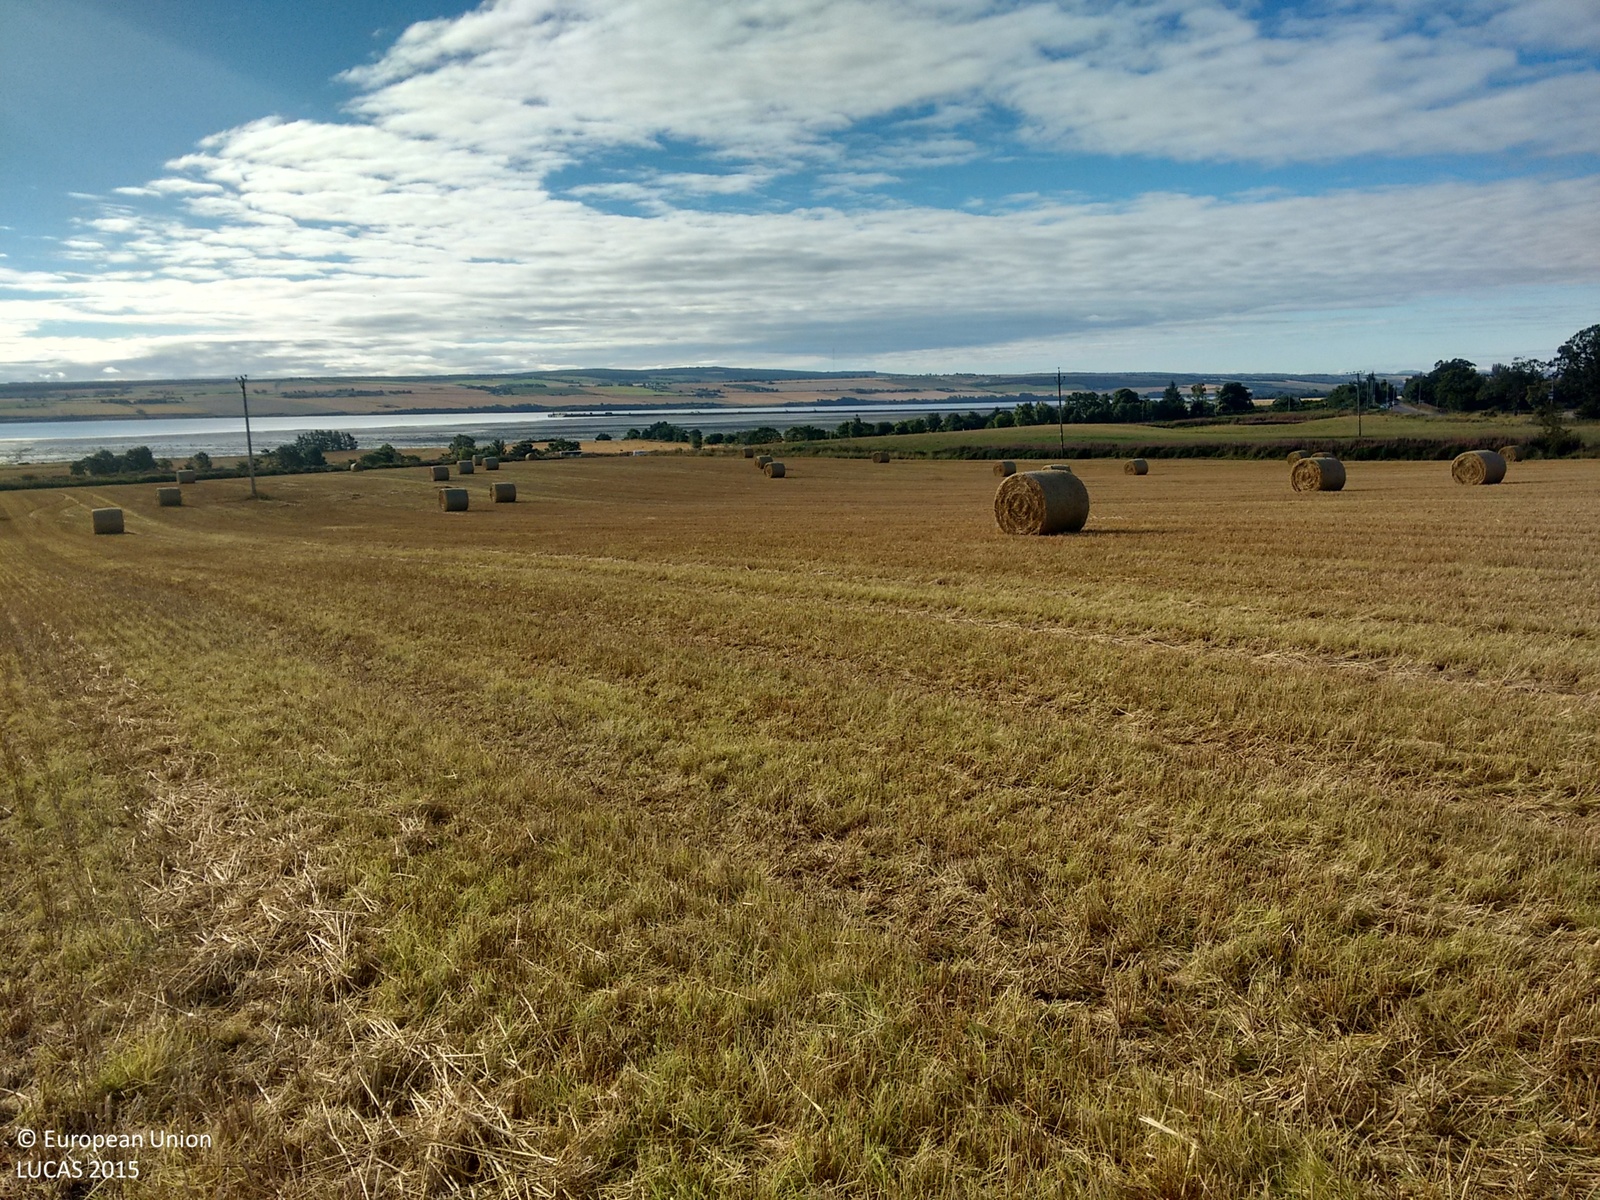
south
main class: Cropland
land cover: Common wheat
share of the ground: > 75 %
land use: Agriculture (excluding fallow land and kitchen gardens)
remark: Harvested field
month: September
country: GB
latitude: 57.6880
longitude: -4.2927
